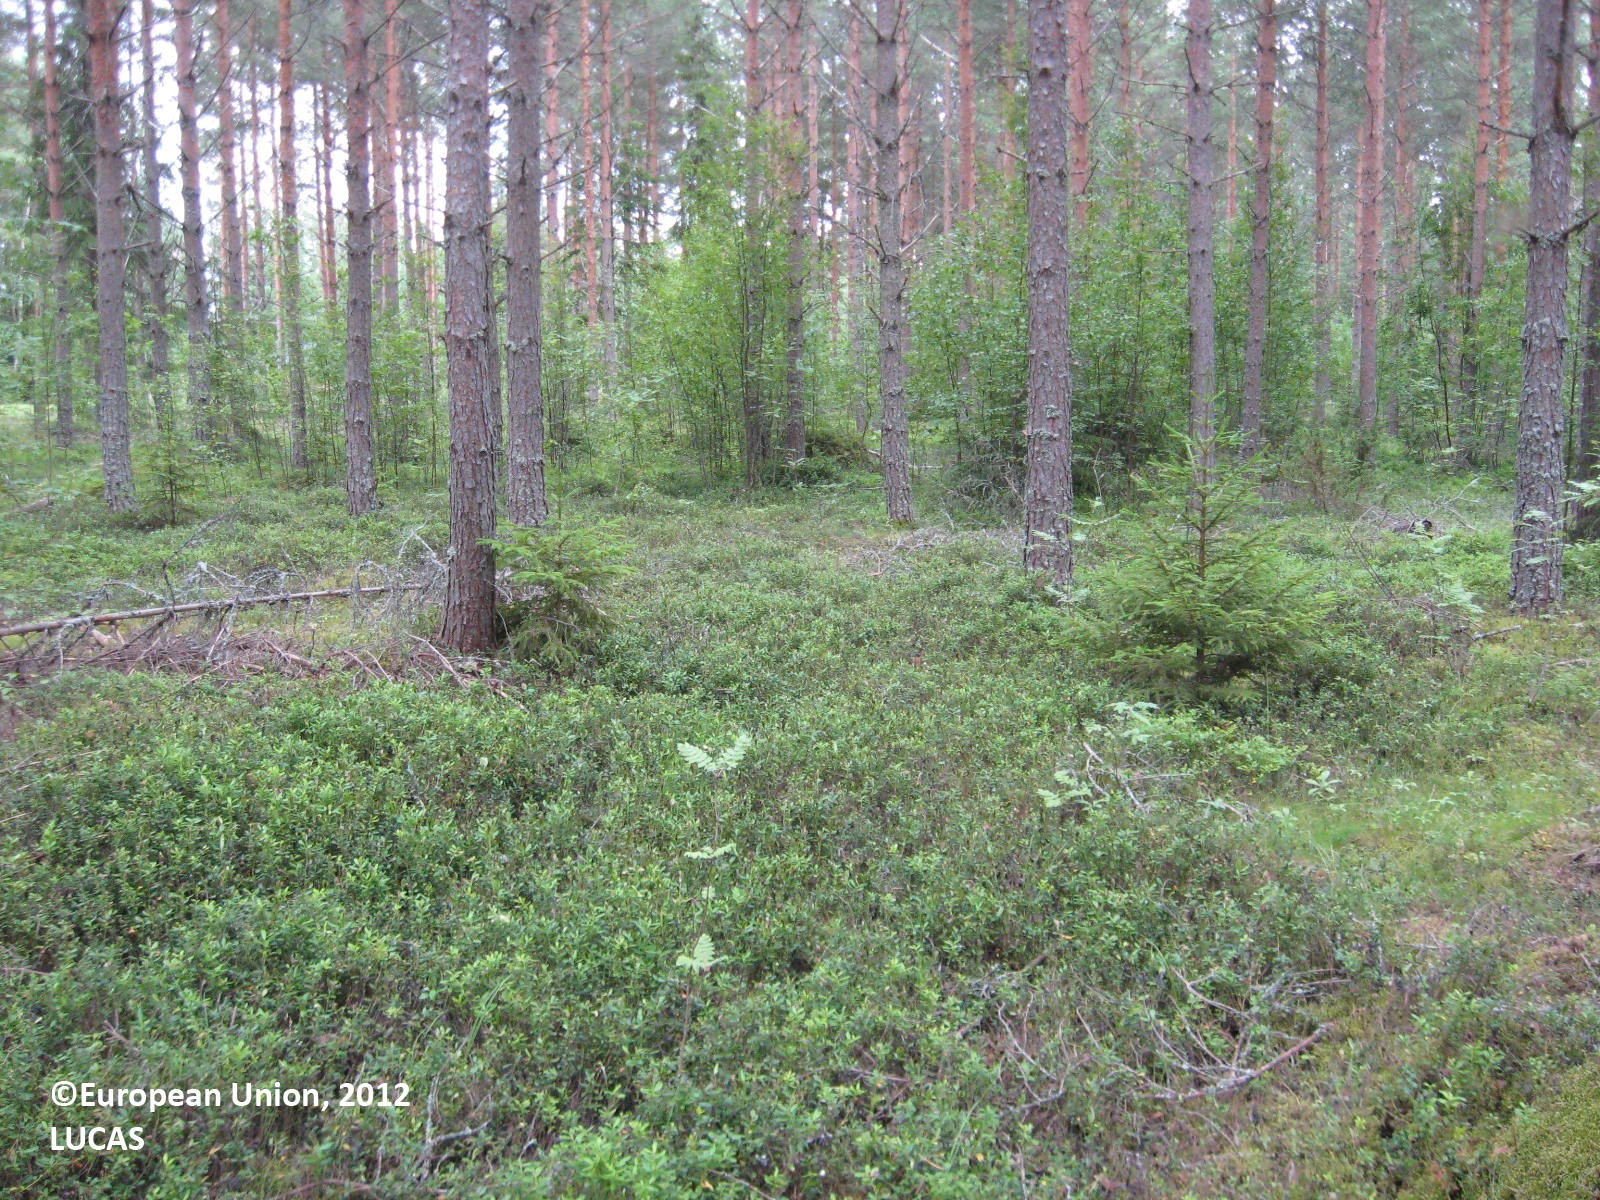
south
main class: Woodland
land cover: Pine dominated coniferous woodland
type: boreal forest
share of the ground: > 75 %
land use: Forestry
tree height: > 5 m
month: July
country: FI
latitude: 62.4854
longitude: 21.1970
